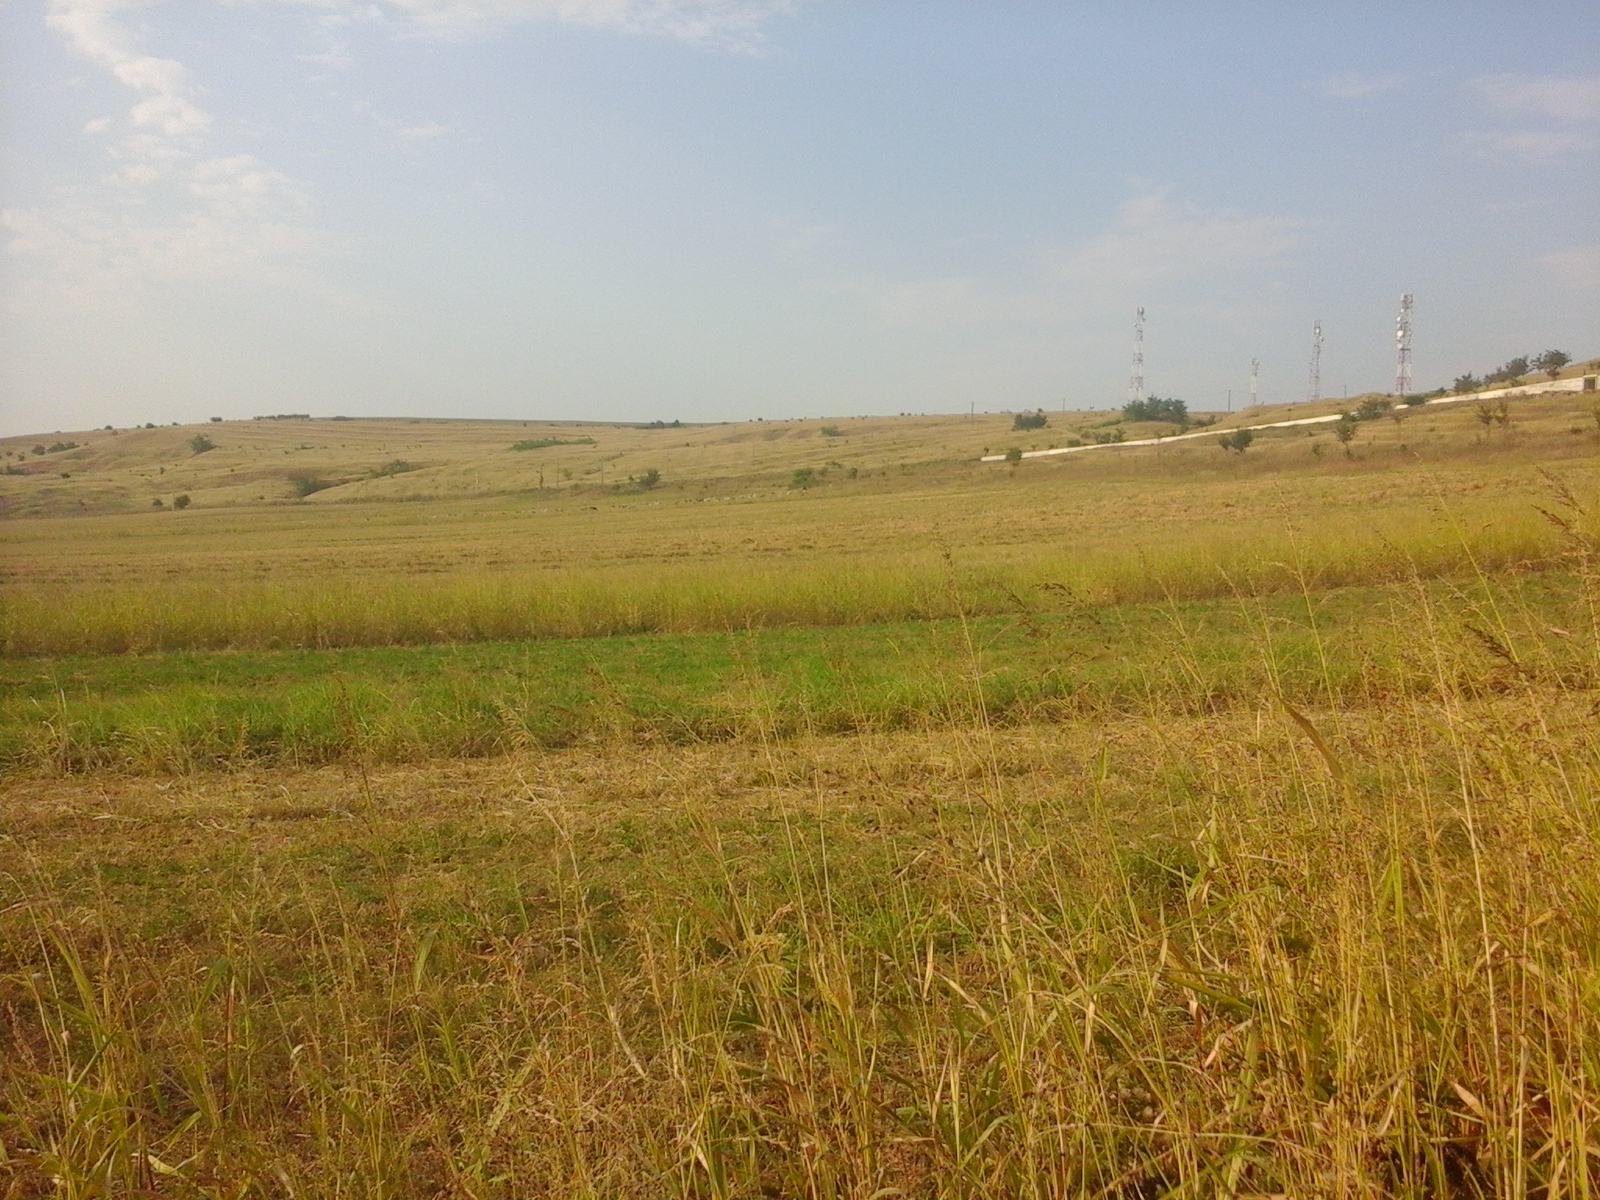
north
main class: Cropland
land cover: Maize
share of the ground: > 75 %
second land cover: Spontaneously vegetated surfaces
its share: 50 - 75 %
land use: Agriculture (excluding fallow land and kitchen gardens)
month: August
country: RO
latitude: 44.1603
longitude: 23.6199
